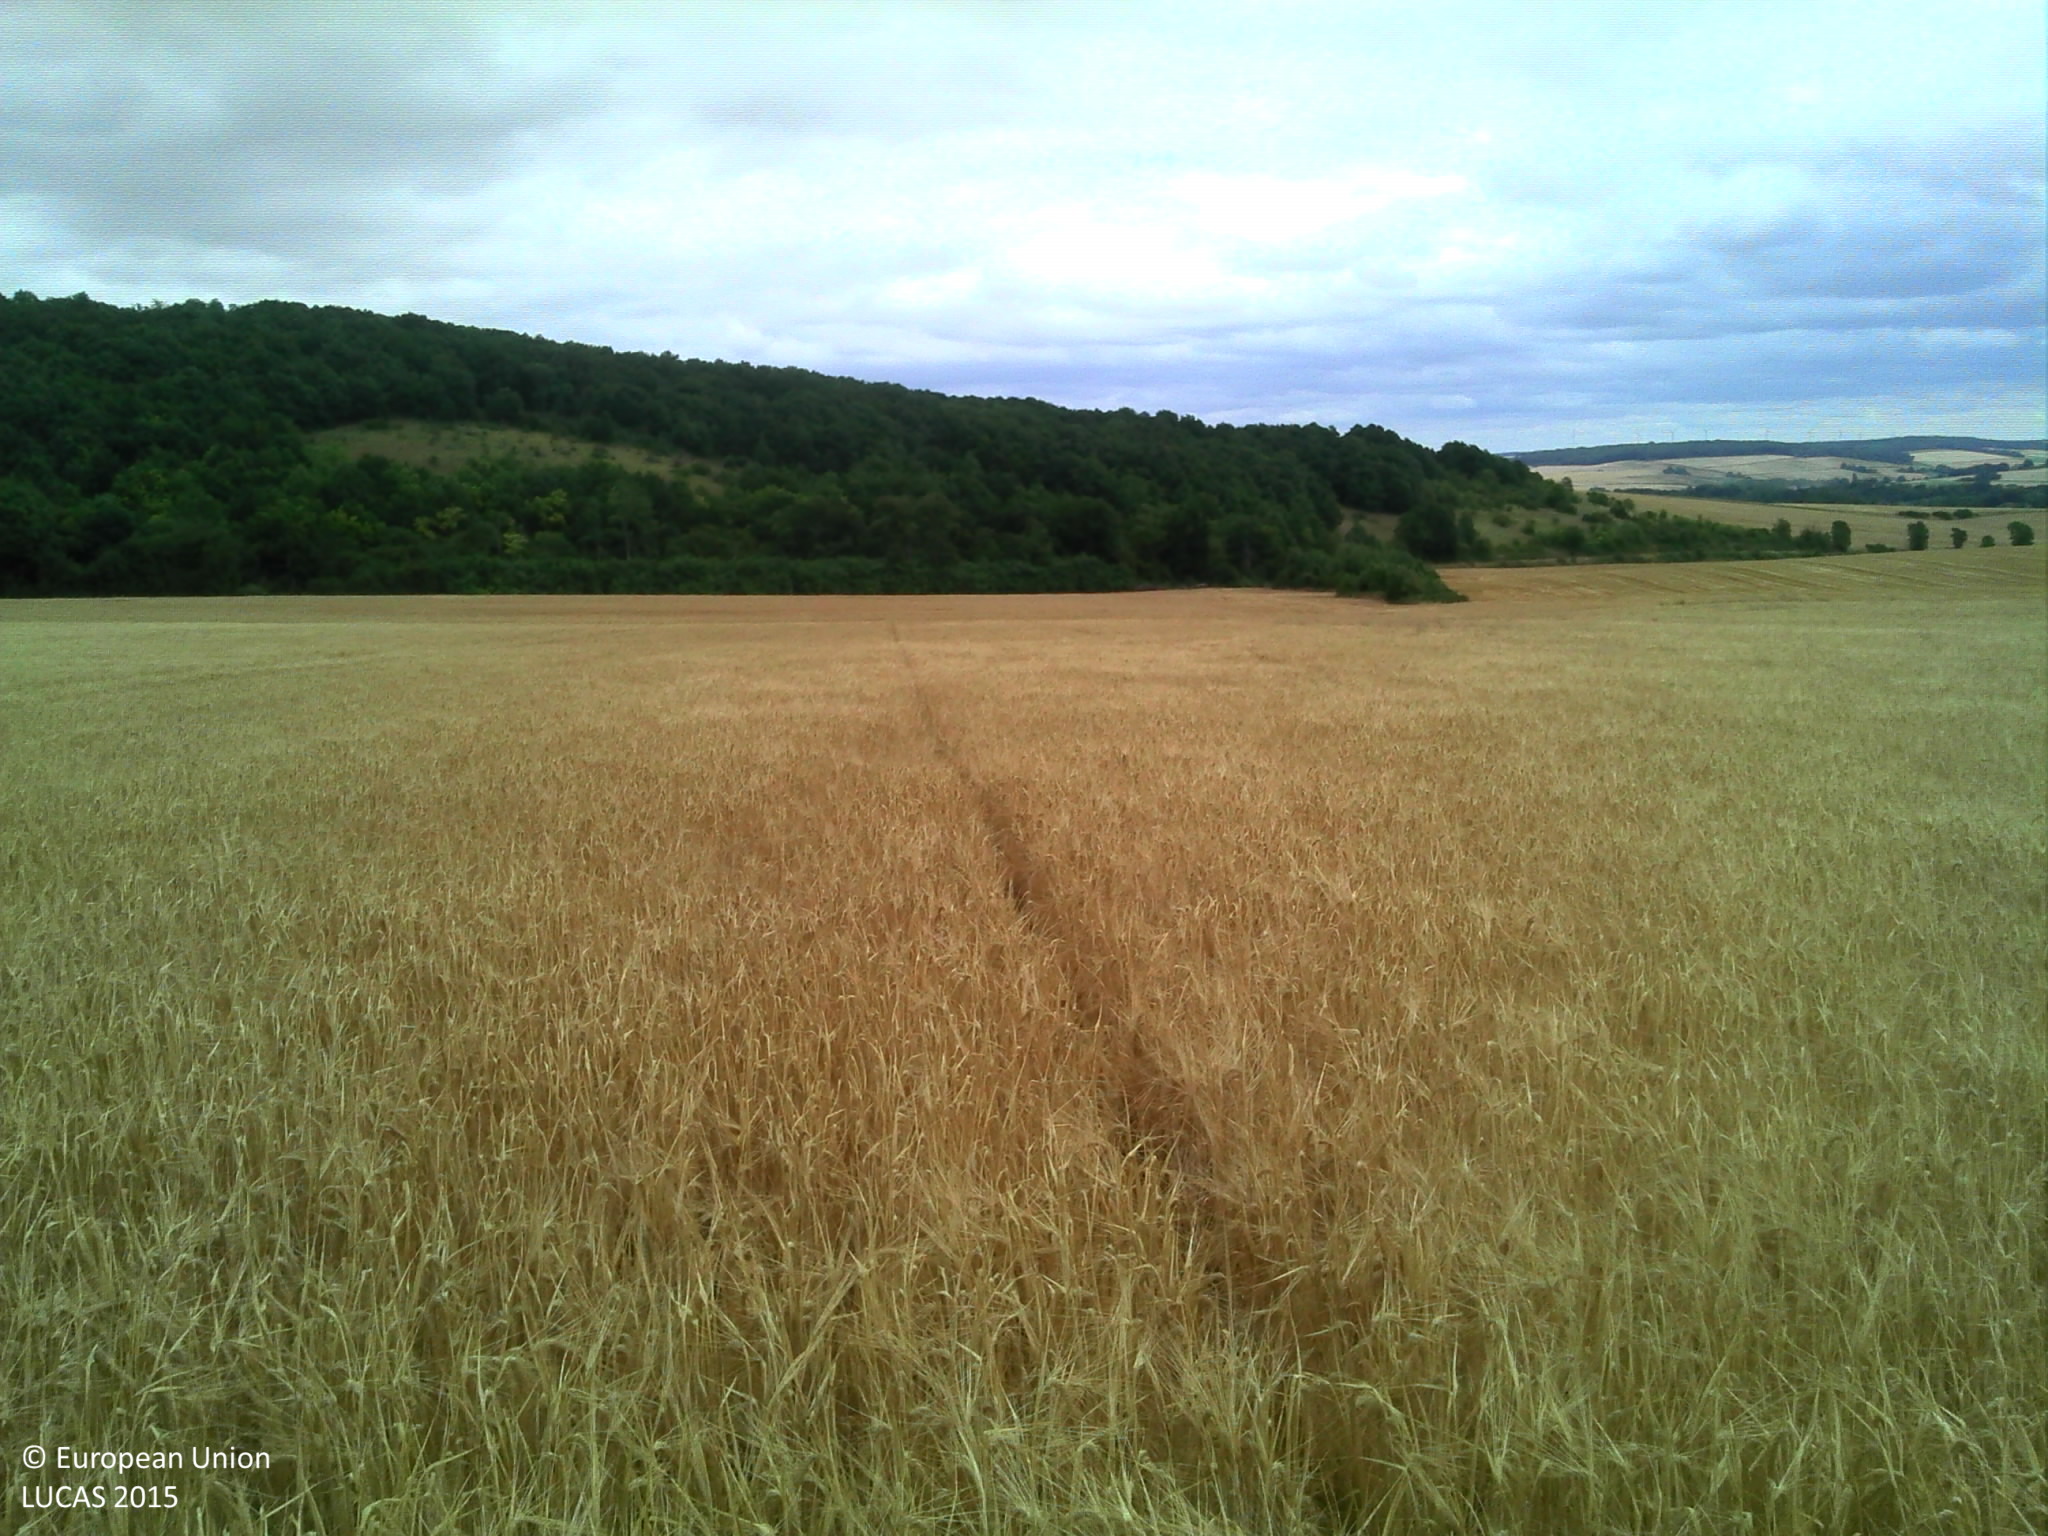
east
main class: Cropland
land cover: Barley
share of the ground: > 75 %
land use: Agriculture (excluding fallow land and kitchen gardens)
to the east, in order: Barley; Common wheat
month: July
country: FR
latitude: 48.1892
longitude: 3.4163
